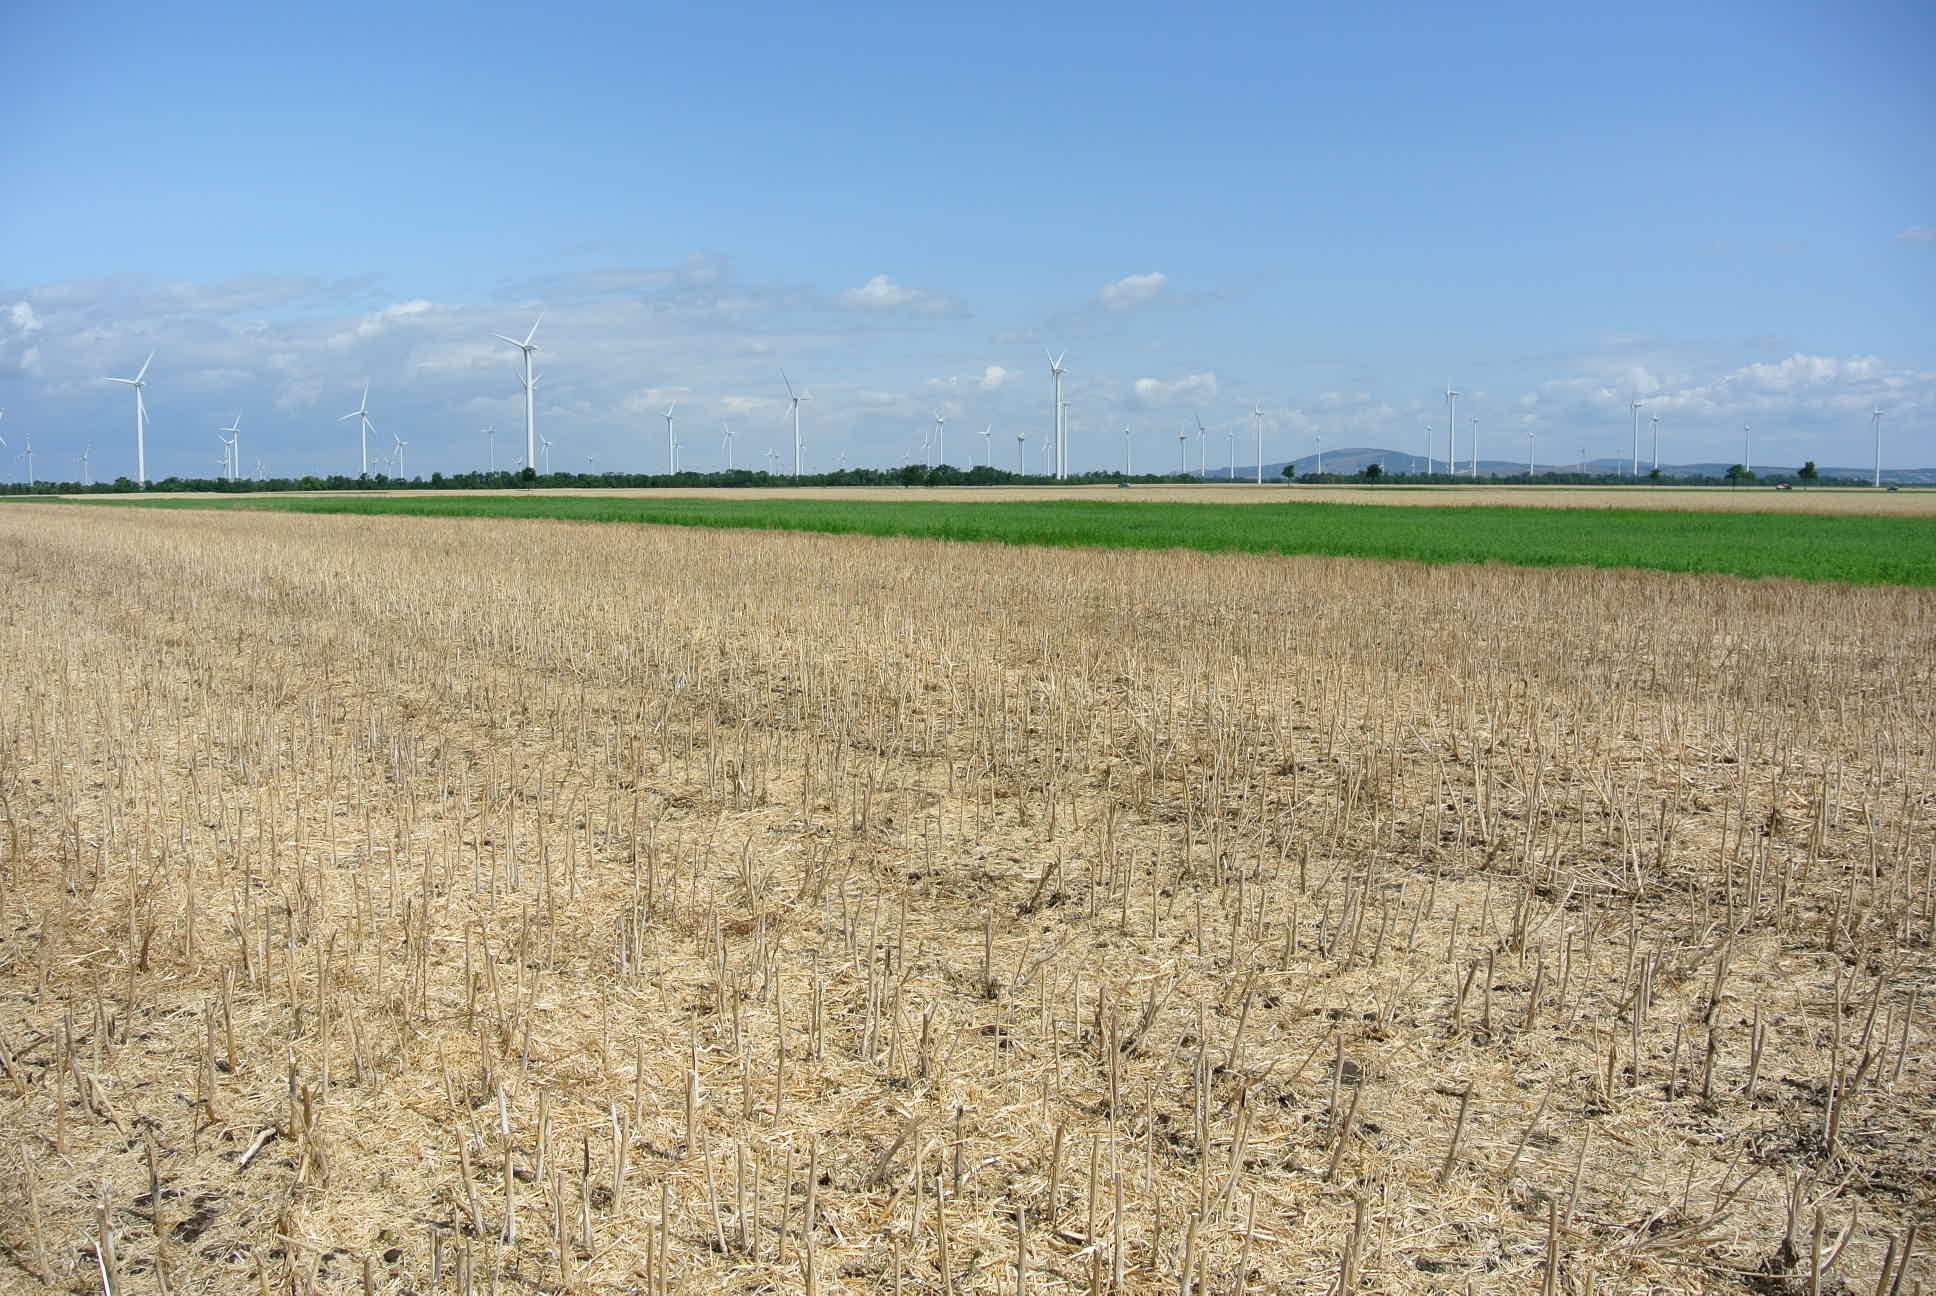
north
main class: Cropland
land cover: Rape and turnip rape
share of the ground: > 75 %
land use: Agriculture (excluding fallow land and kitchen gardens)
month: July
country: AT
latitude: 48.0067
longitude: 16.9099
